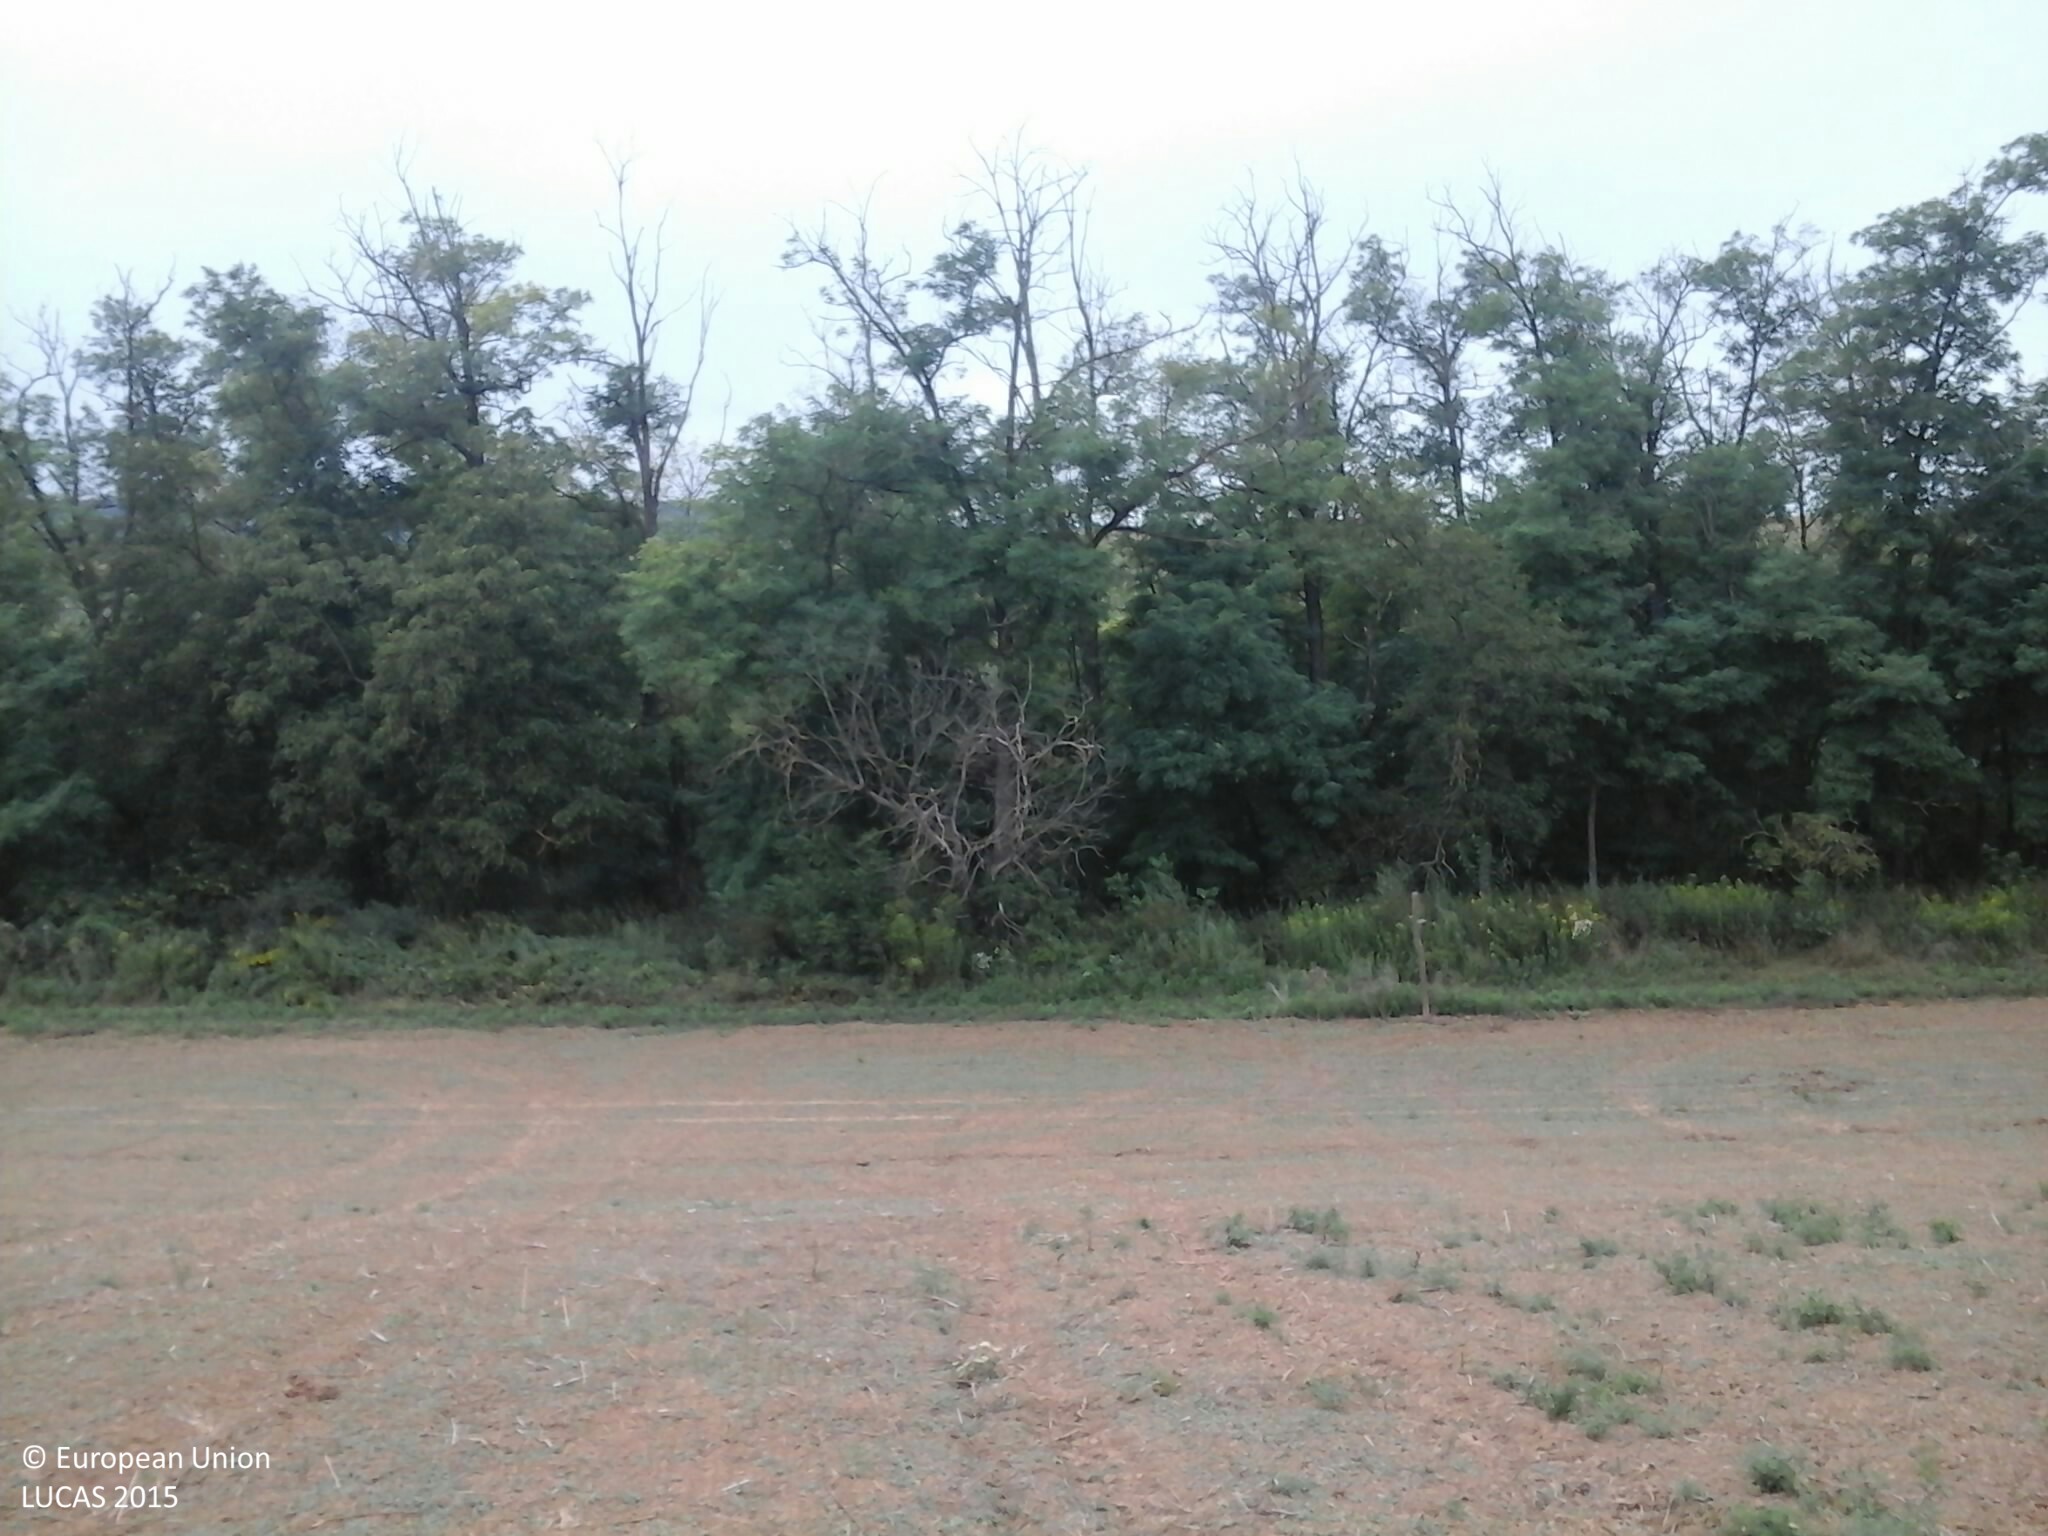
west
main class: Cropland
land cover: Rape and turnip rape
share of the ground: < 10 %
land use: Agriculture (excluding fallow land and kitchen gardens)
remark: Harvested field
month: July
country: HU
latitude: 46.7302
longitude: 17.8719
